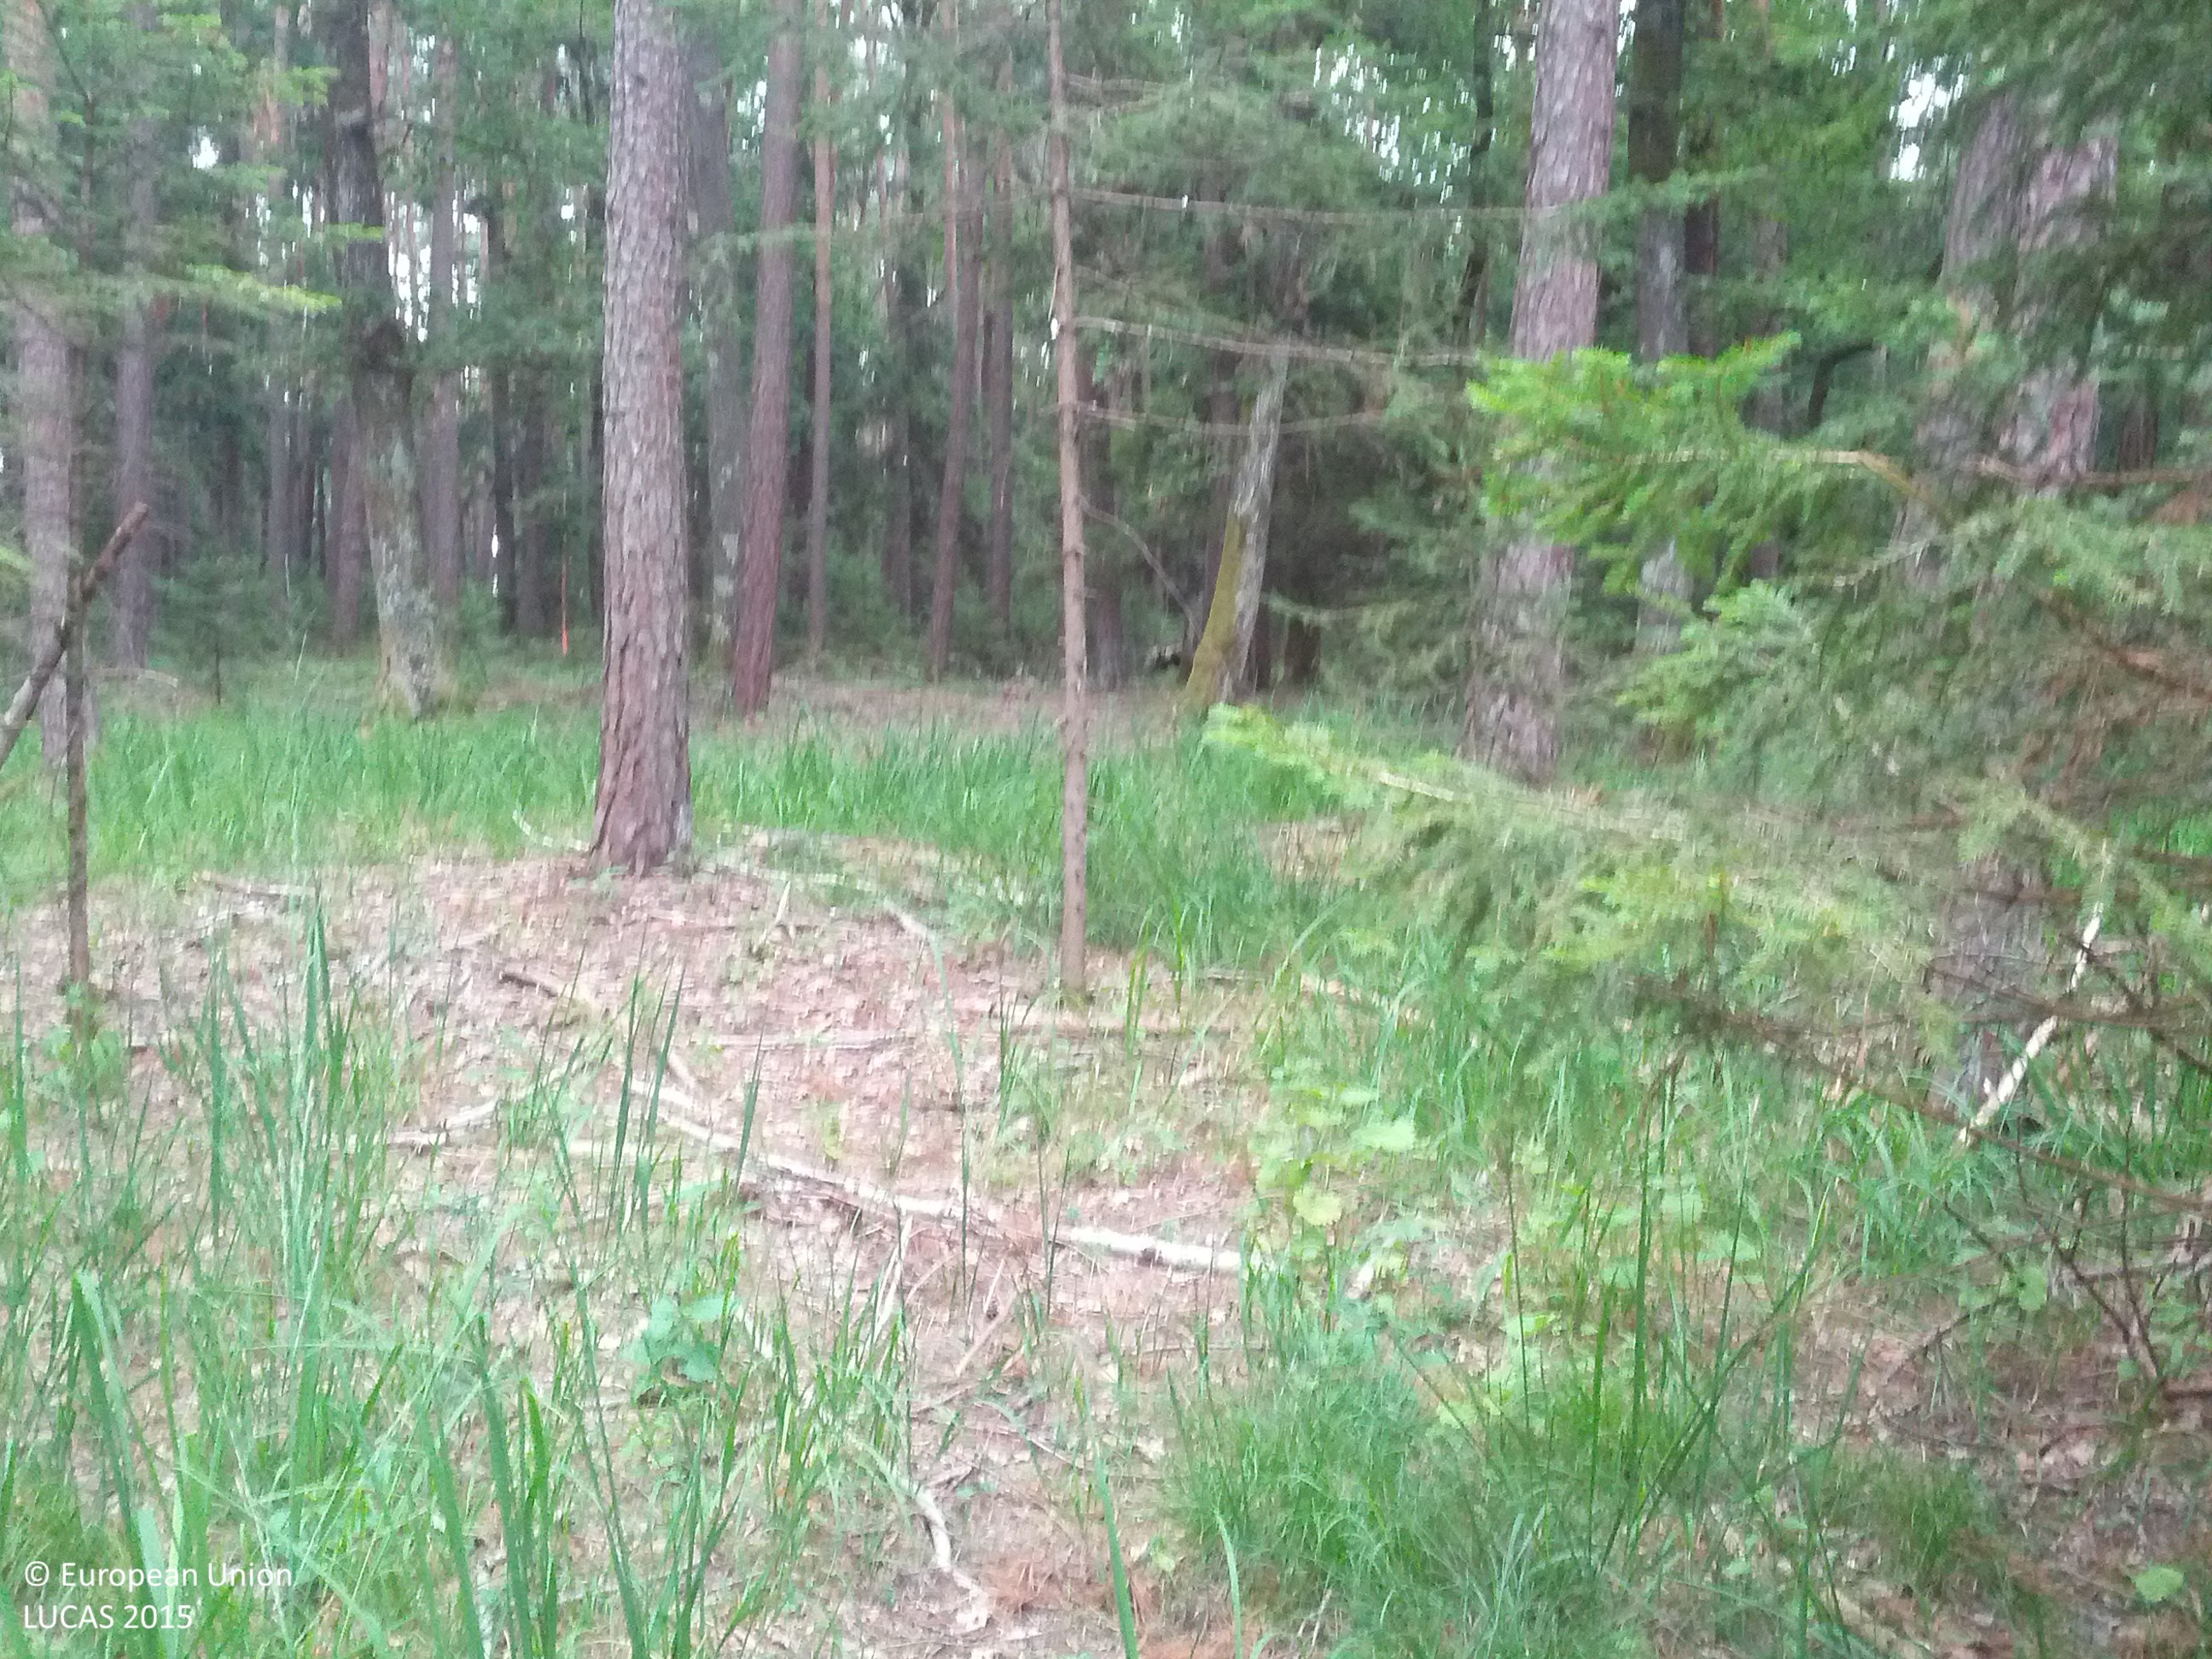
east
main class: Woodland
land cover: Pine dominated coniferous woodland
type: hemiboreal forest and nemoral coniferous forest and mixed broadleaved-coniferous forest
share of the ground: > 75 %
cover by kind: coniferous forest trees 80 %, herbaceous plants 15 %, unconsolidated bare surface 5 %
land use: Forestry
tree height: > 5 m
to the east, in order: Pine dominated coniferous woodland; Tracks; Pine dominated mixed woodland; Spruce dominated coniferous woodland; Tracks; Spruce dominated coniferous woodland
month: July
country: AT
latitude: 47.3475
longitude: 16.1575
